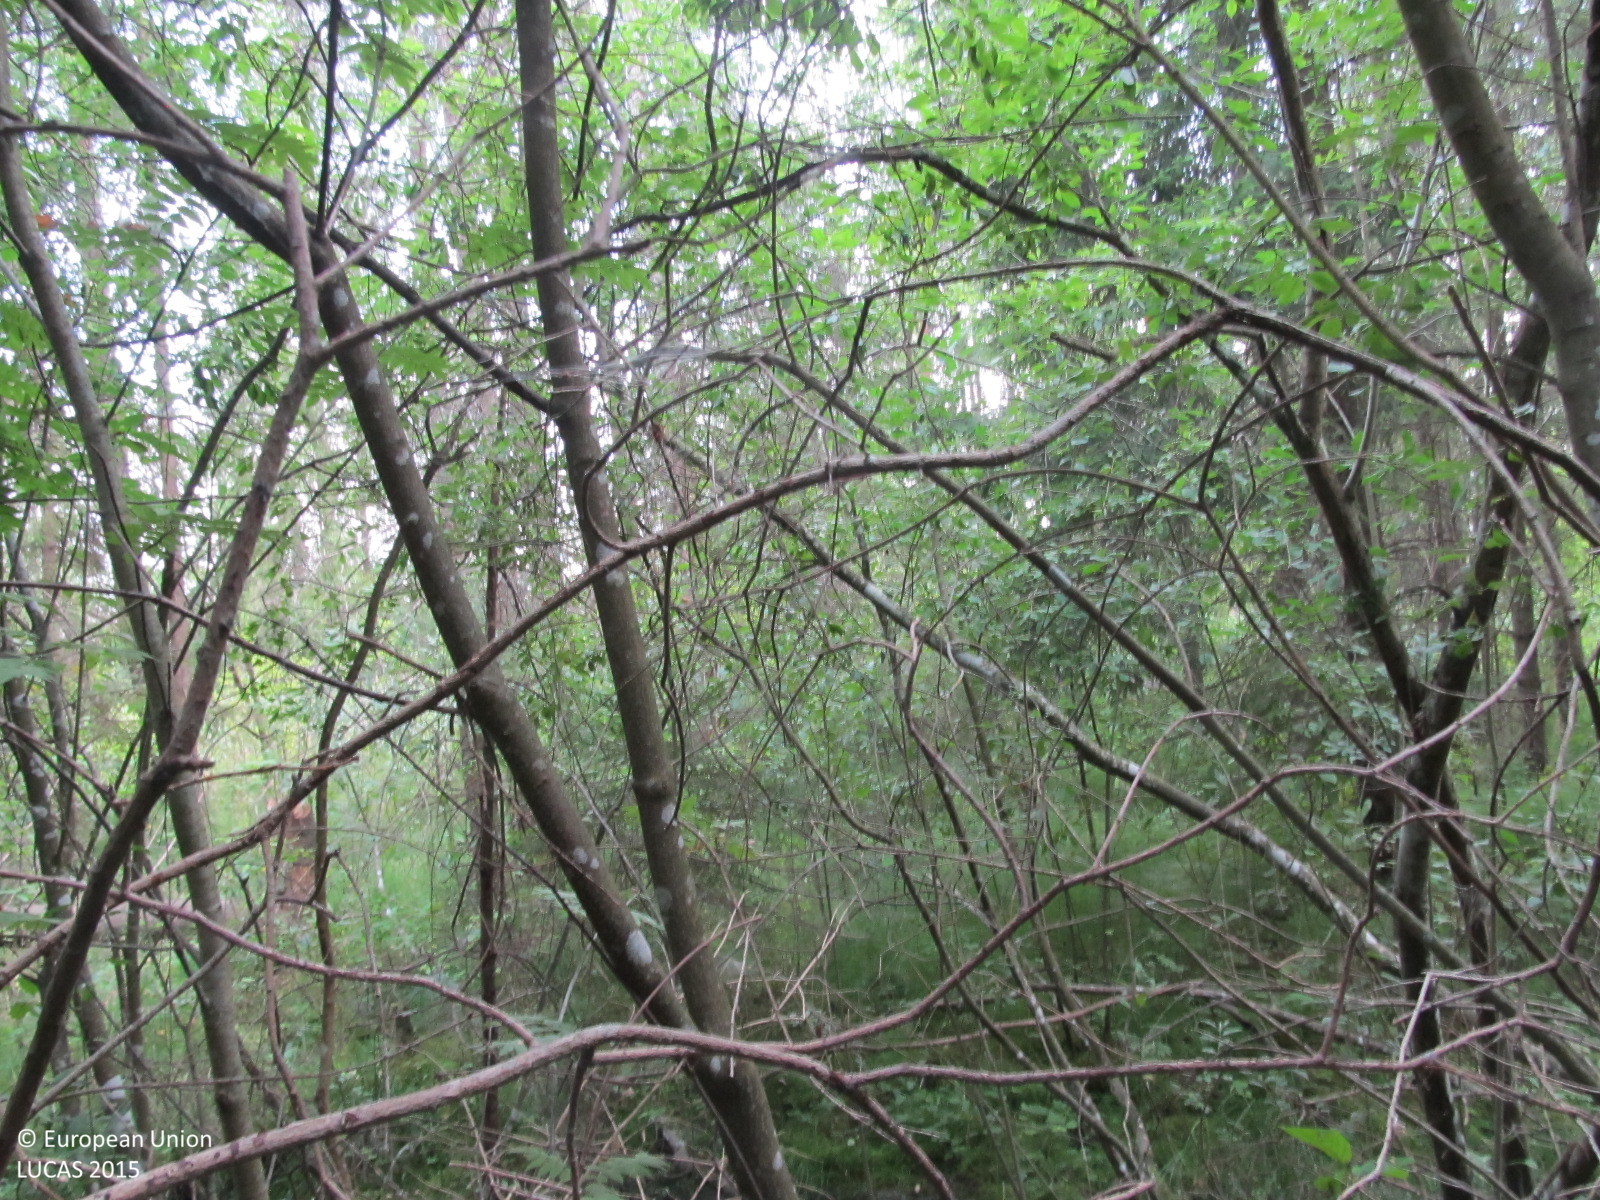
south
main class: Woodland
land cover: Other mixed woodland
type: hemiboreal forest and nemoral coniferous forest and mixed broadleaved-coniferous forest
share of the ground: > 75 %
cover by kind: coniferous forest trees 50 %, broadleaved forest trees 30 %, herbaceous plants 15 %, shrubs 5 %
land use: Forestry
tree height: > 5 m
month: August
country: LT
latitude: 55.8566
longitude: 23.1226
